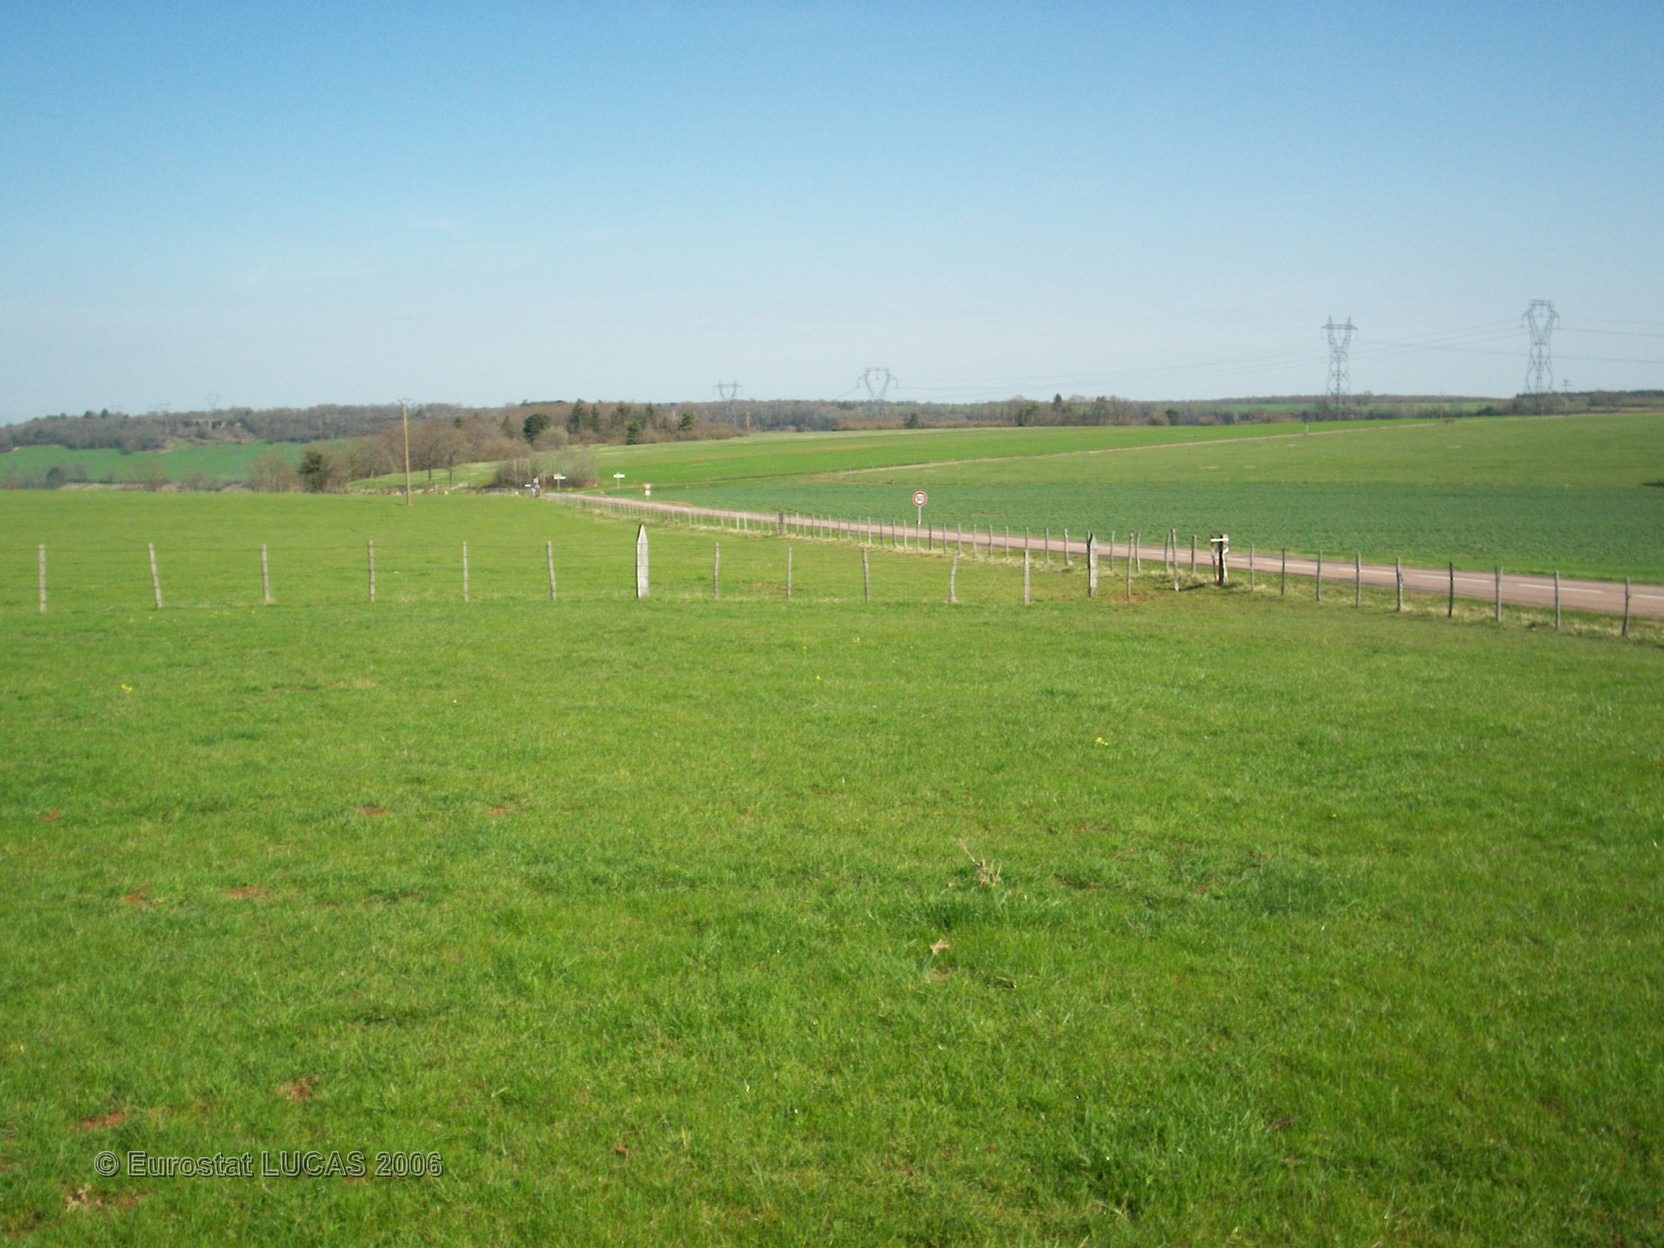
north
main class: Grassland
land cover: Grassland without tree/shrub cover
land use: Agriculture (excluding fallow land and kitchen gardens)
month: April
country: FR
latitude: 47.3869
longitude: 4.5815
